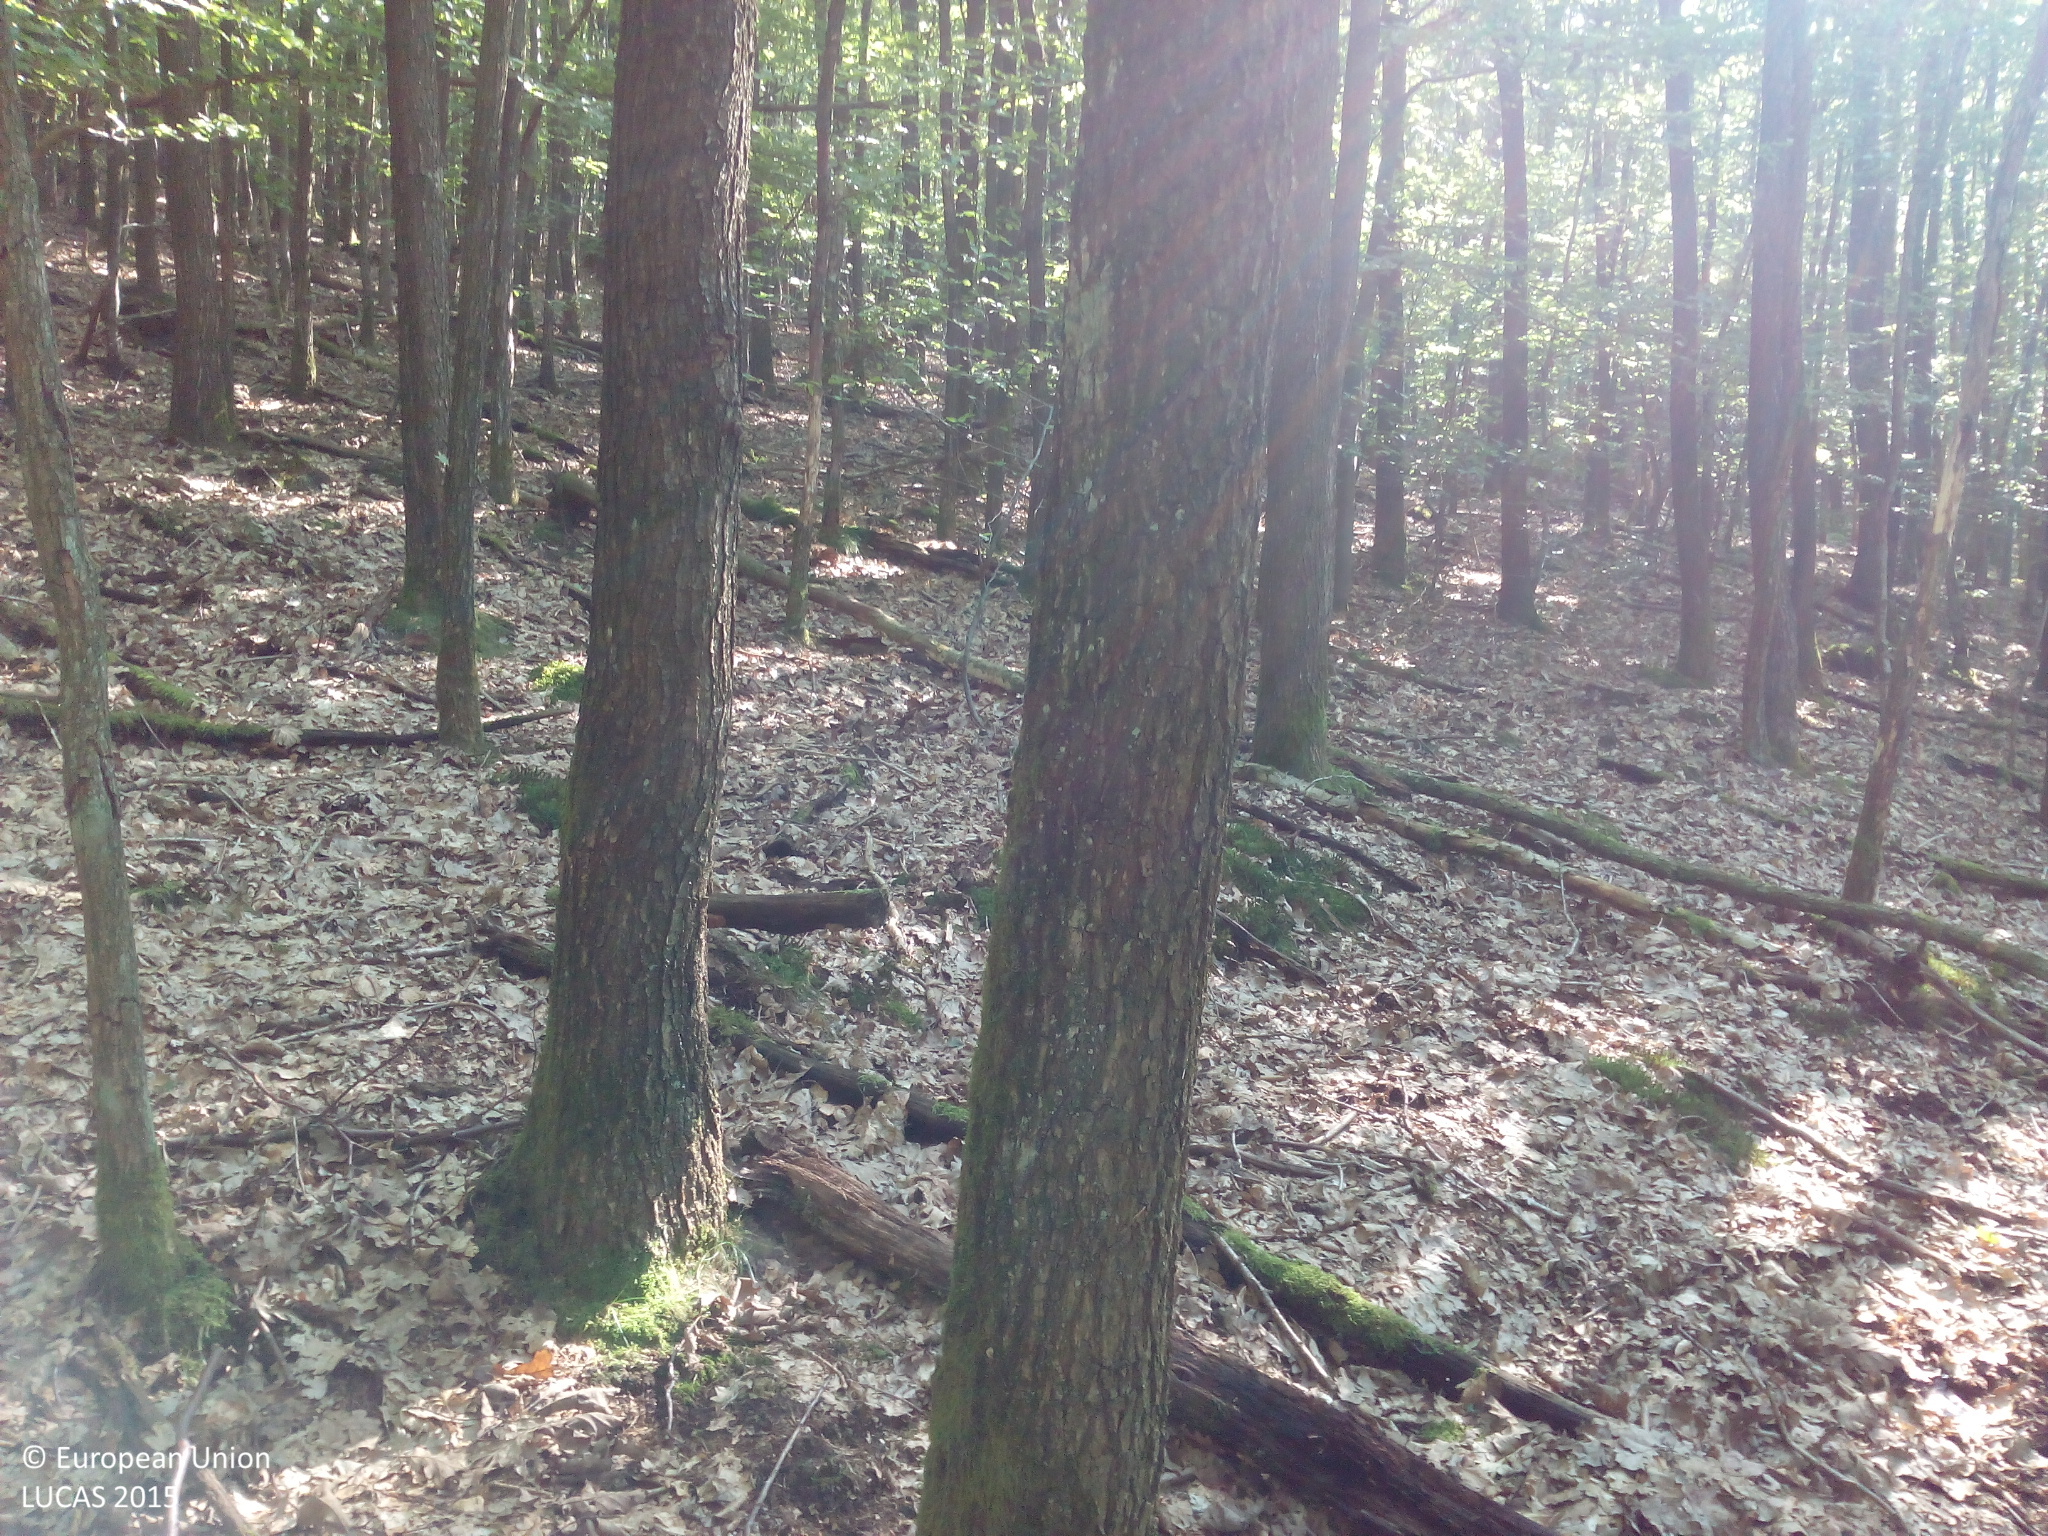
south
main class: Woodland
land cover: Broadleaved woodland
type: acidophilous oak and oak-birch forest
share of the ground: > 75 %
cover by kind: broadleaved forest trees 90 %, unconsolidated bare surface 10 %
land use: Forestry
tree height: > 5 m
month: September
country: DE
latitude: 49.8410
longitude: 9.4023
